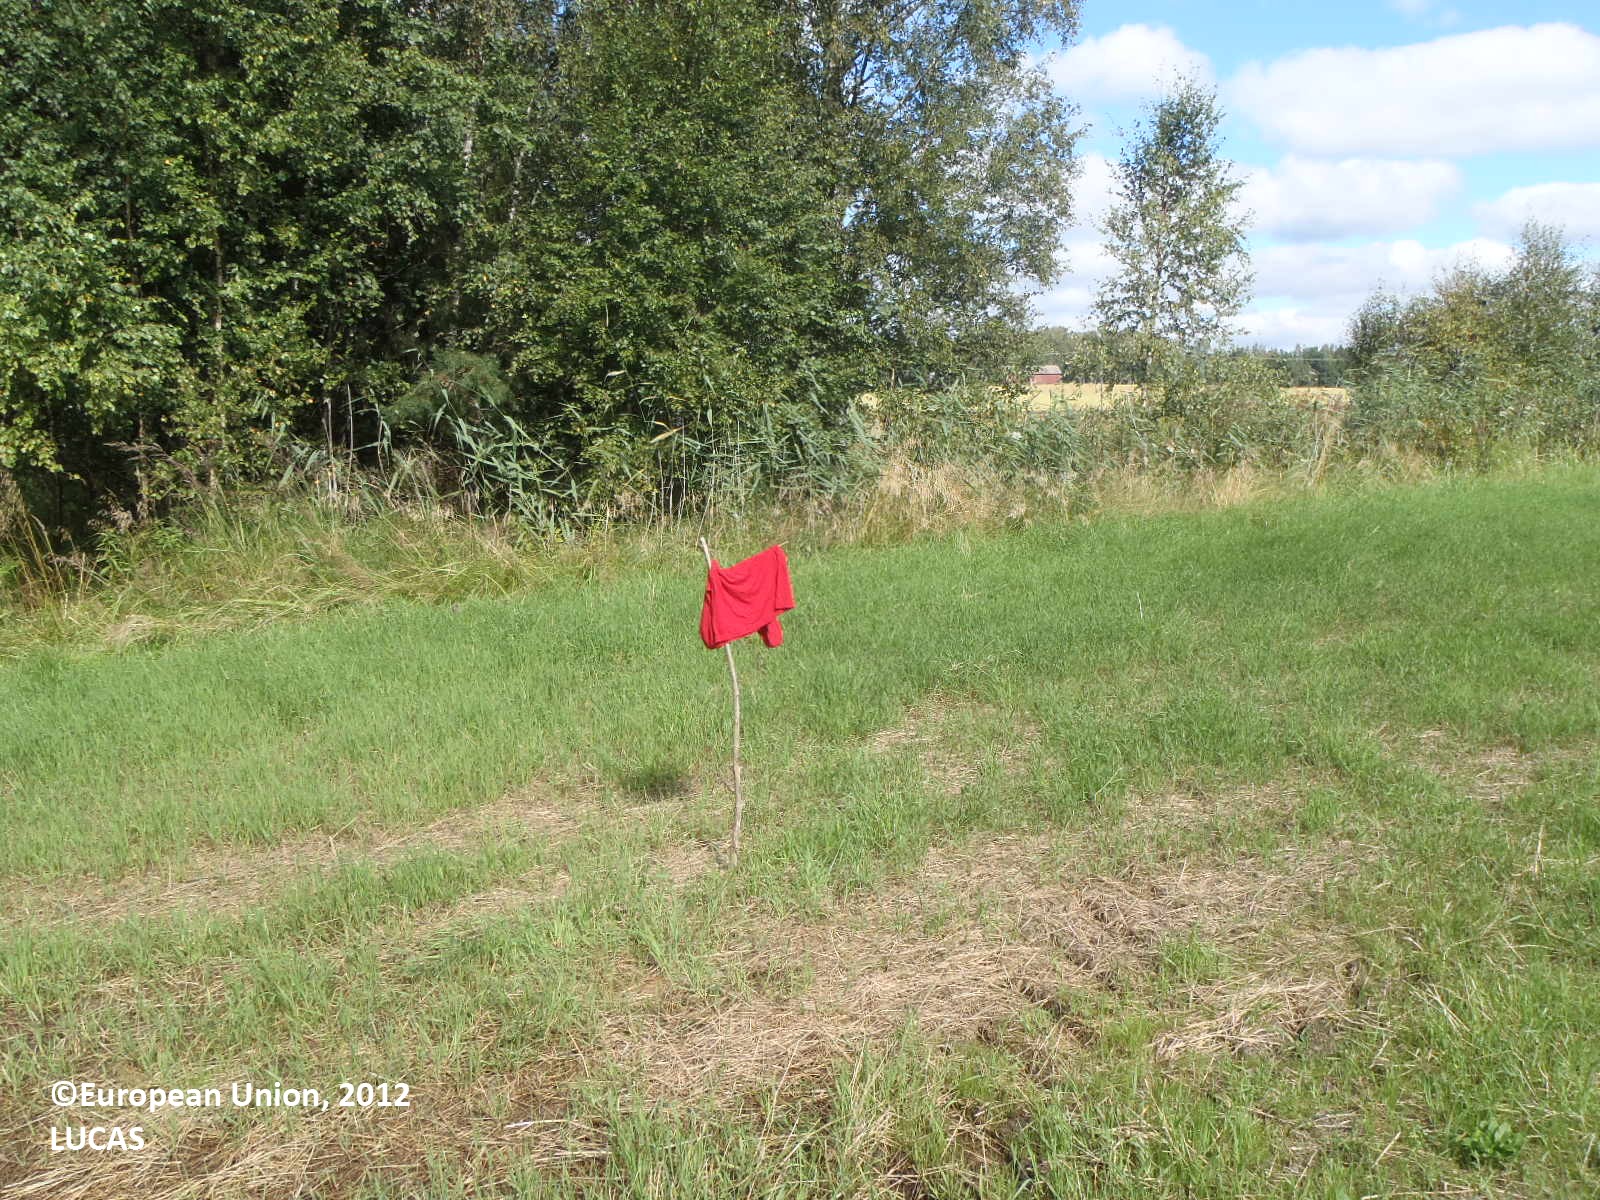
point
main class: Cropland
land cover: Temporary grasslands
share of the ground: > 75 %
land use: Agriculture (excluding fallow land and kitchen gardens)
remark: Harvested field
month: August
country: FI
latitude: 60.3953
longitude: 22.4279
